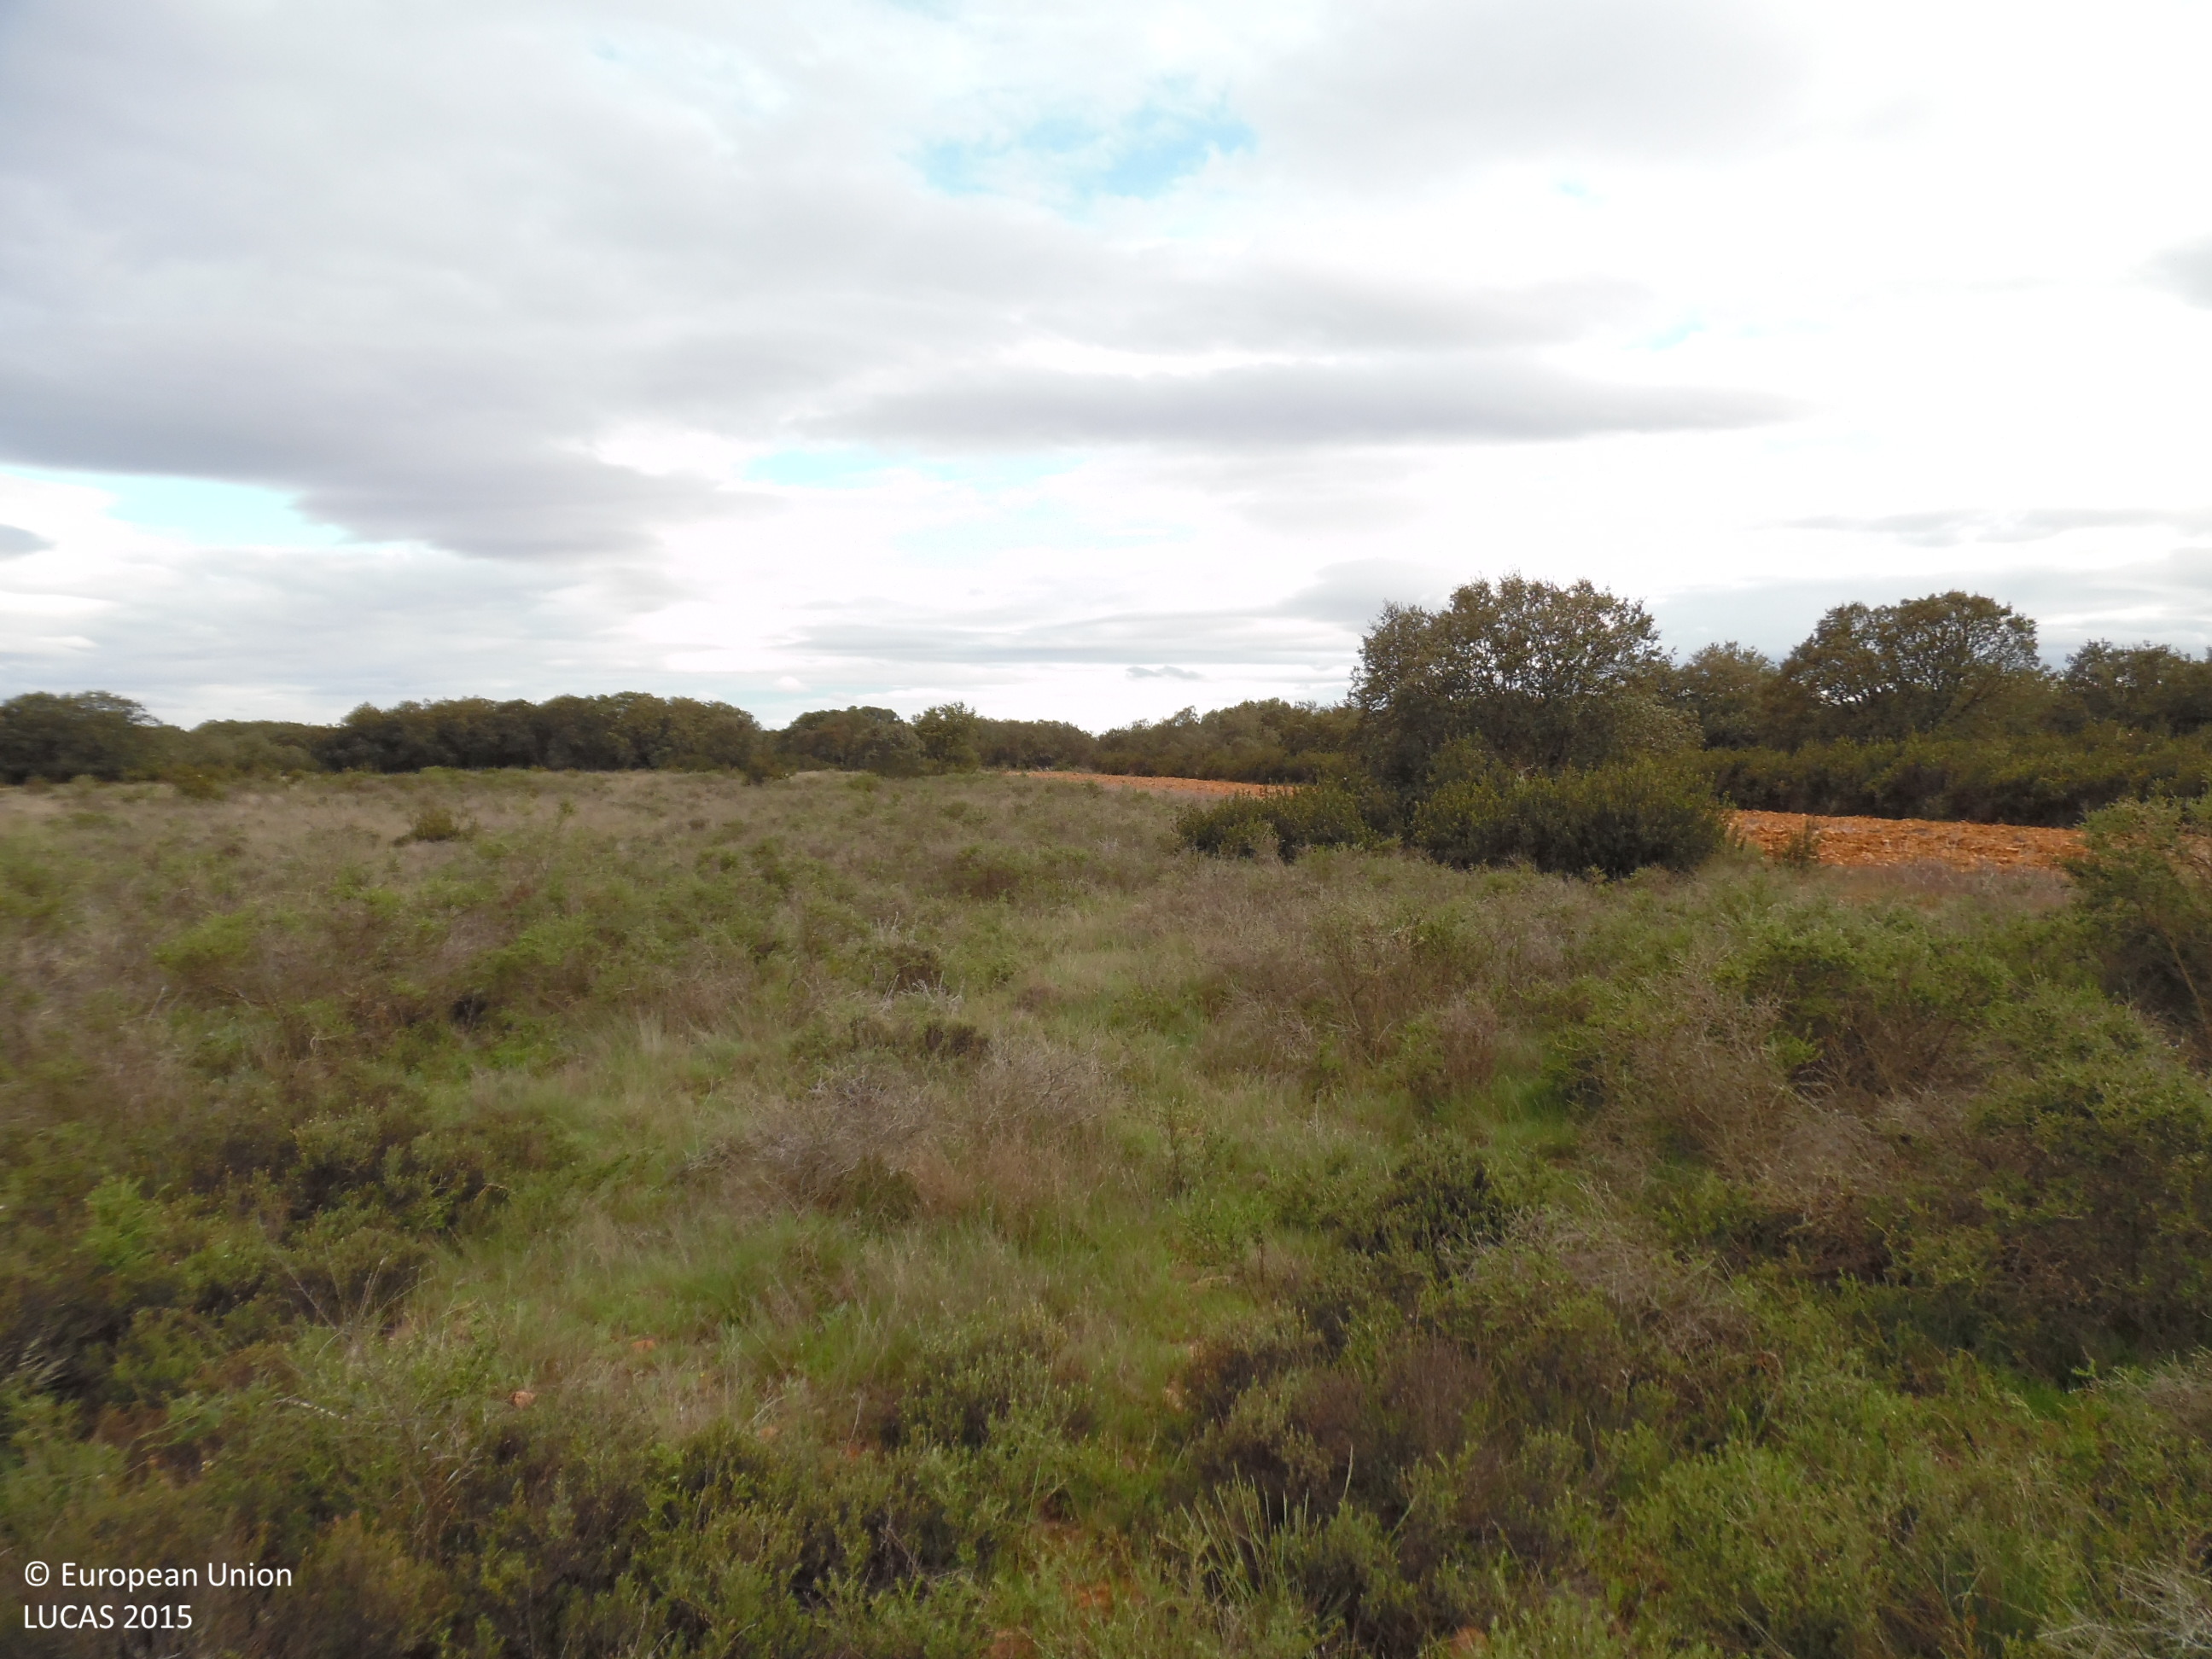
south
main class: Shrubland
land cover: Shrubland without tree cover
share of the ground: > 75 %
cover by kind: shrubs 100 %
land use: Abandoned areas
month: April
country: ES
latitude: 42.1813
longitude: -5.9977
